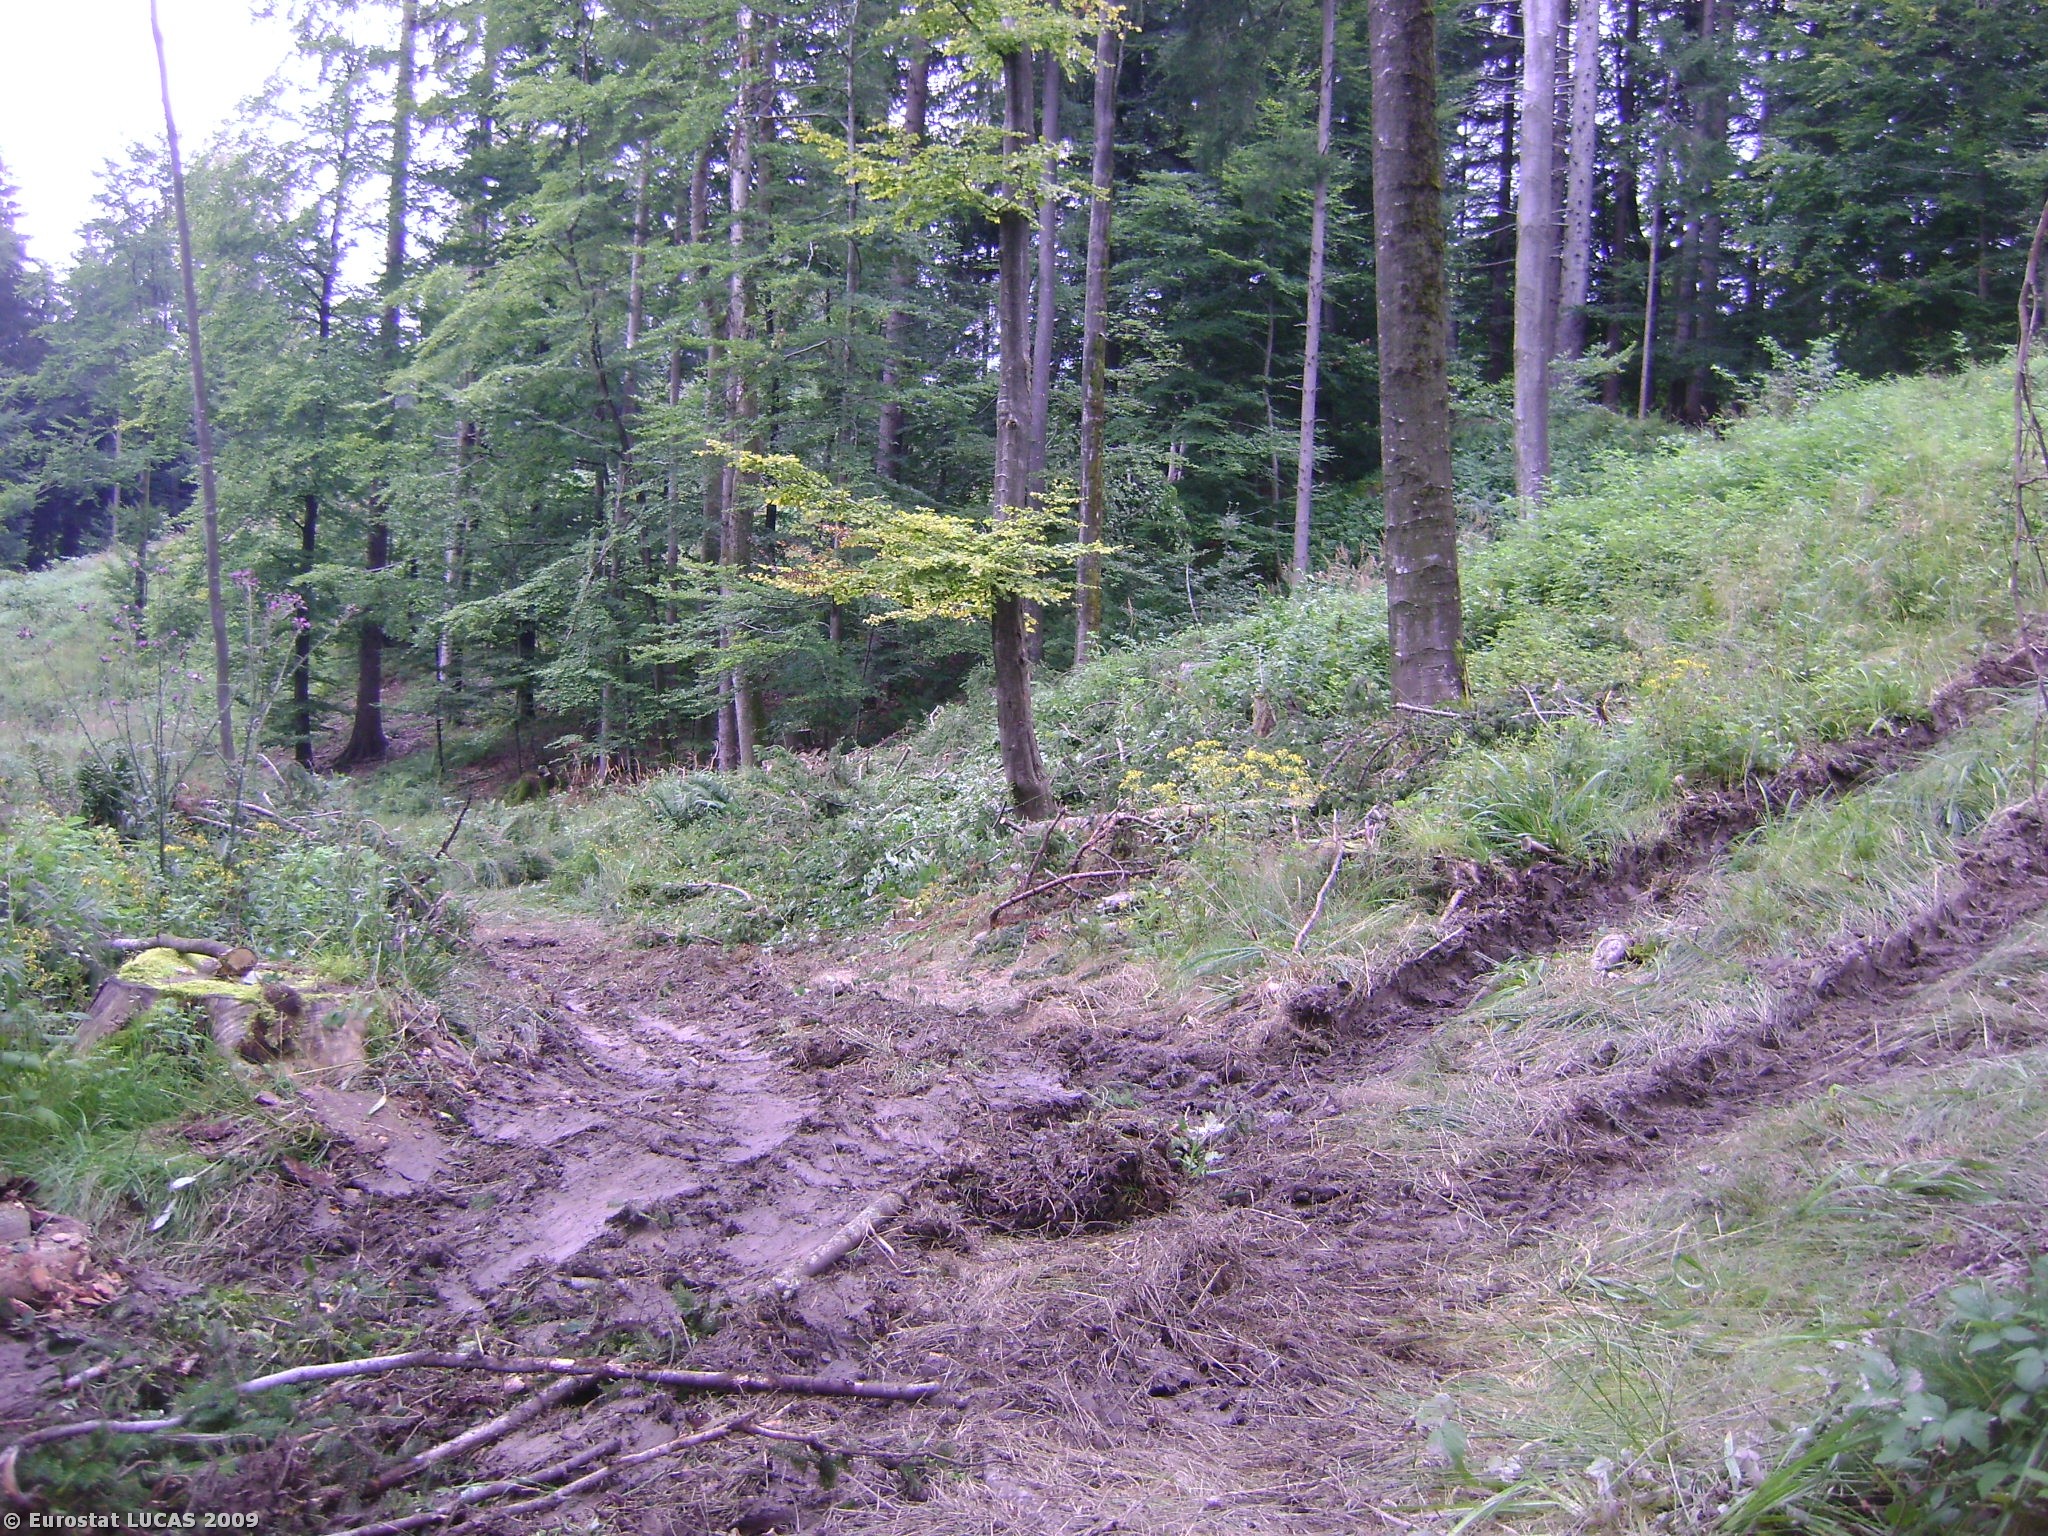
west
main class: Shrubland
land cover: Shrubland with sparse tree cover
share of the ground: > 75 %
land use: Forestry
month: August
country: AT
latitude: 47.8704
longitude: 13.2207
